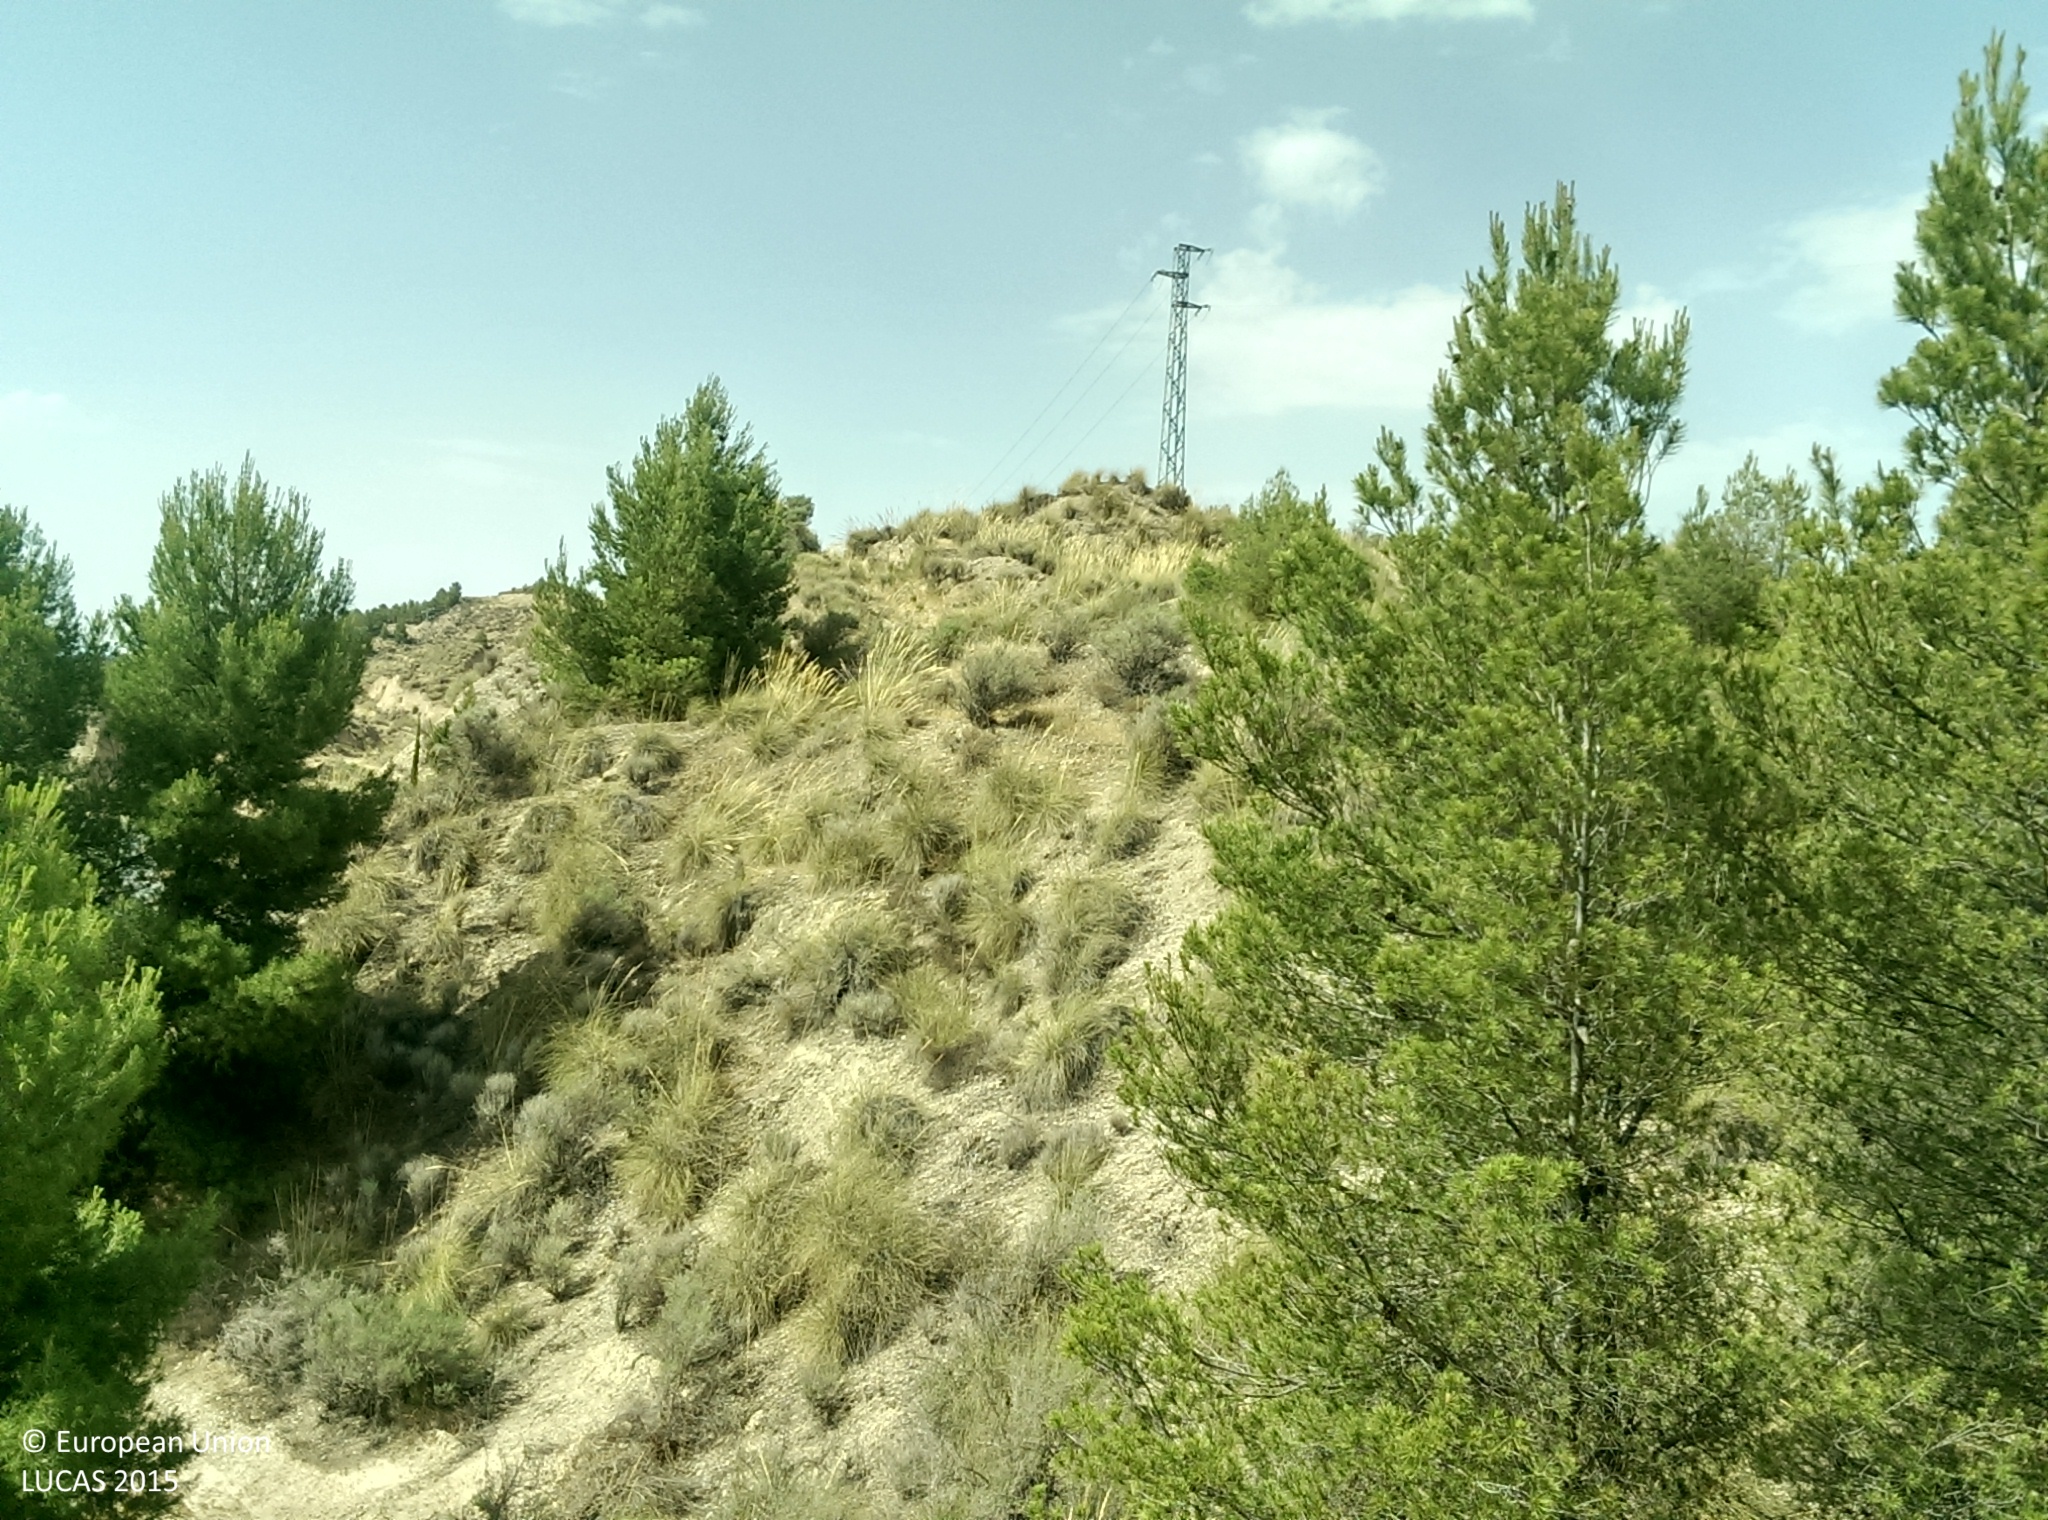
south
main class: Woodland
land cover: Pine dominated coniferous woodland
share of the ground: 50 - 75 %
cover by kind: coniferous forest trees 70 %, herbaceous plants 20 %, unconsolidated bare surface 10 %
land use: Forestry
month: July
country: ES
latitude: 37.5727
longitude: -2.9540
